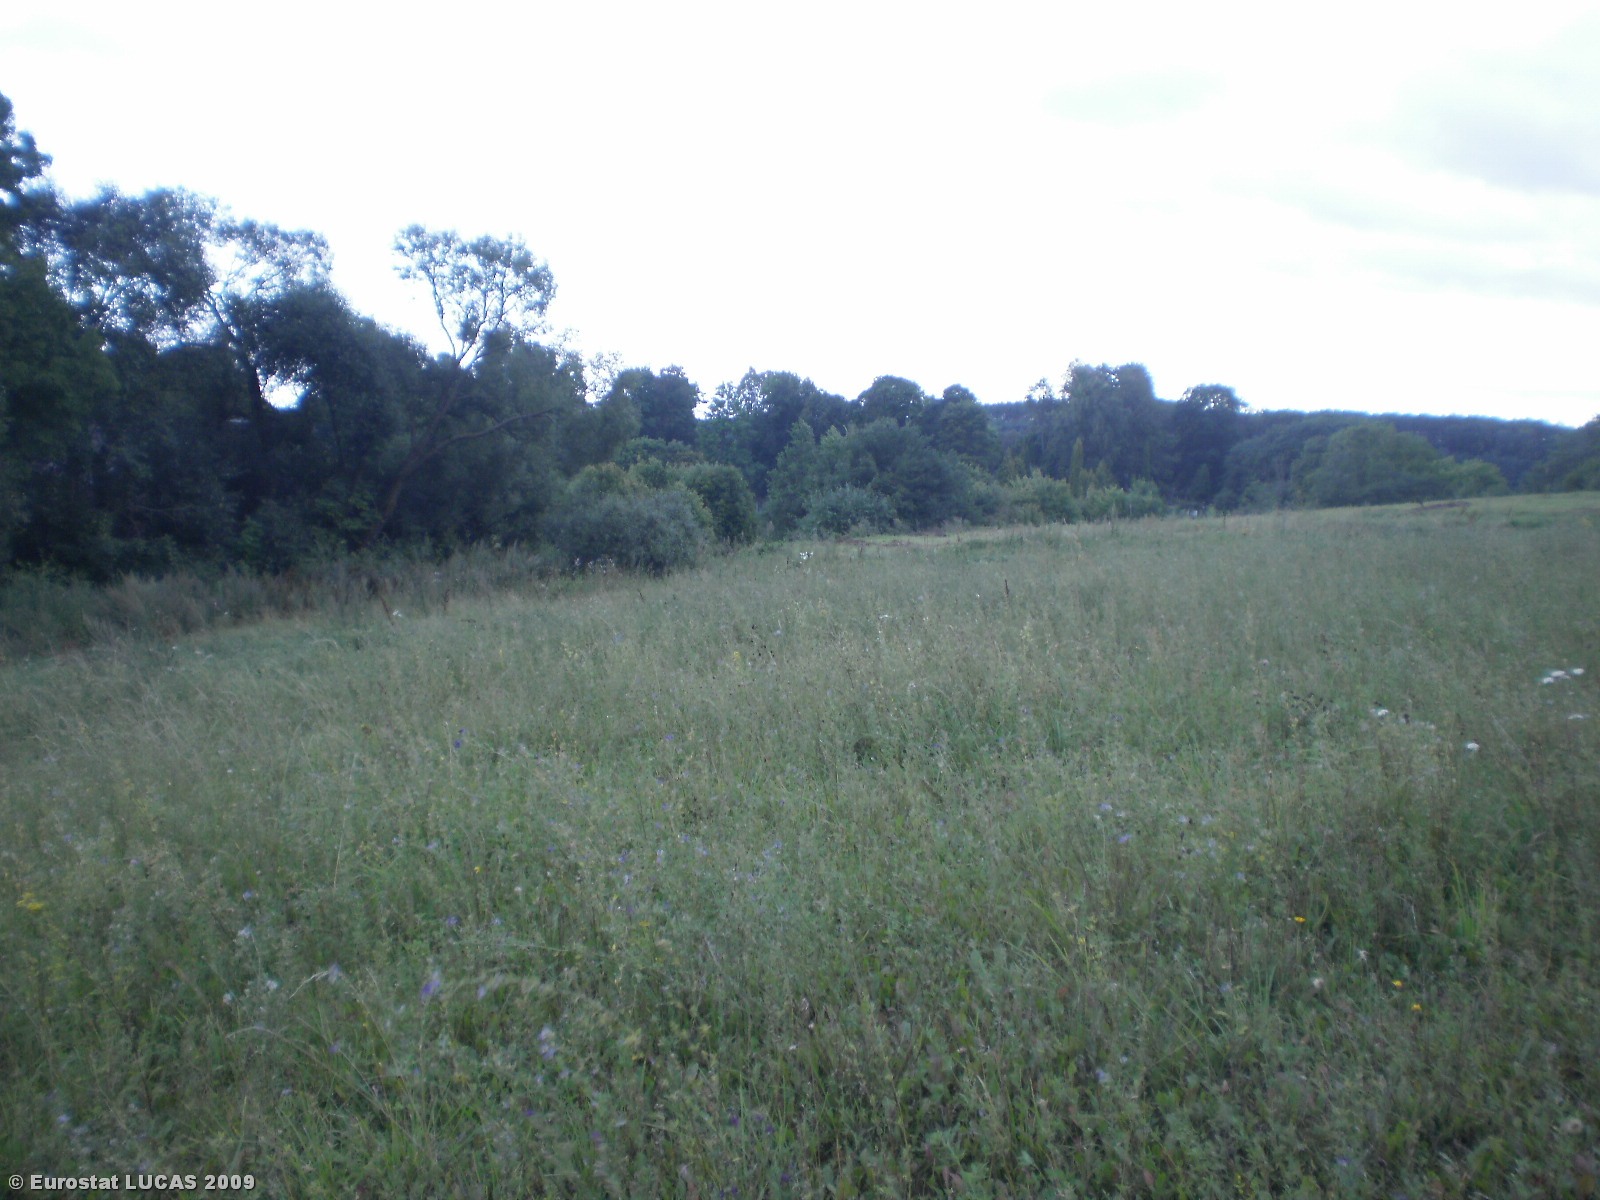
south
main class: Grassland
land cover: Grassland without tree/shrub cover
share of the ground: > 75 %
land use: Agriculture (excluding fallow land and kitchen gardens)
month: August
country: LT
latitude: 55.0599
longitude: 25.4522
